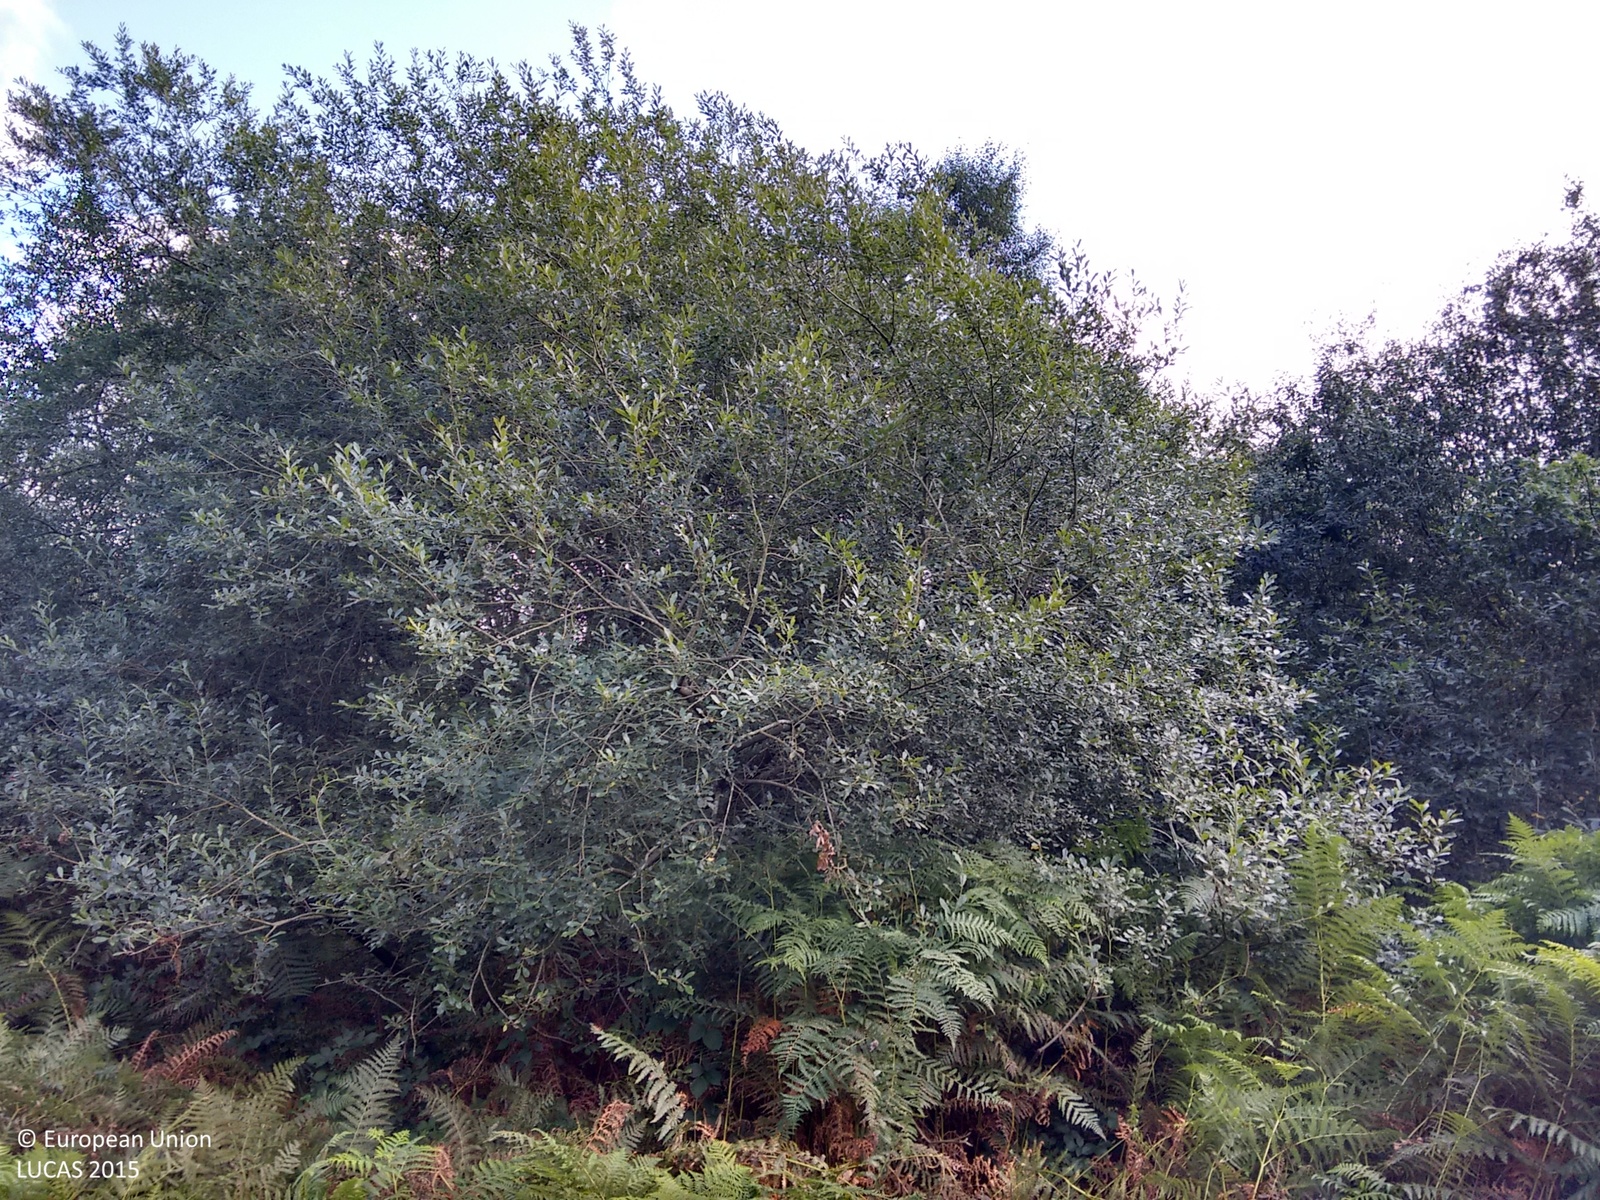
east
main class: Woodland
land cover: Broadleaved woodland
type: mesophytic deciduous forest
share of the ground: > 75 %
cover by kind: herbaceous plants 80 %, broadleaved forest trees 20 %
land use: Agriculture (excluding fallow land and kitchen gardens)
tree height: < 5 m
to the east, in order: Broadleaved woodland; Grassland with sparse tree/shrub cover; Broadleaved woodland
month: September
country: GB
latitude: 52.1504
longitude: -3.4861
